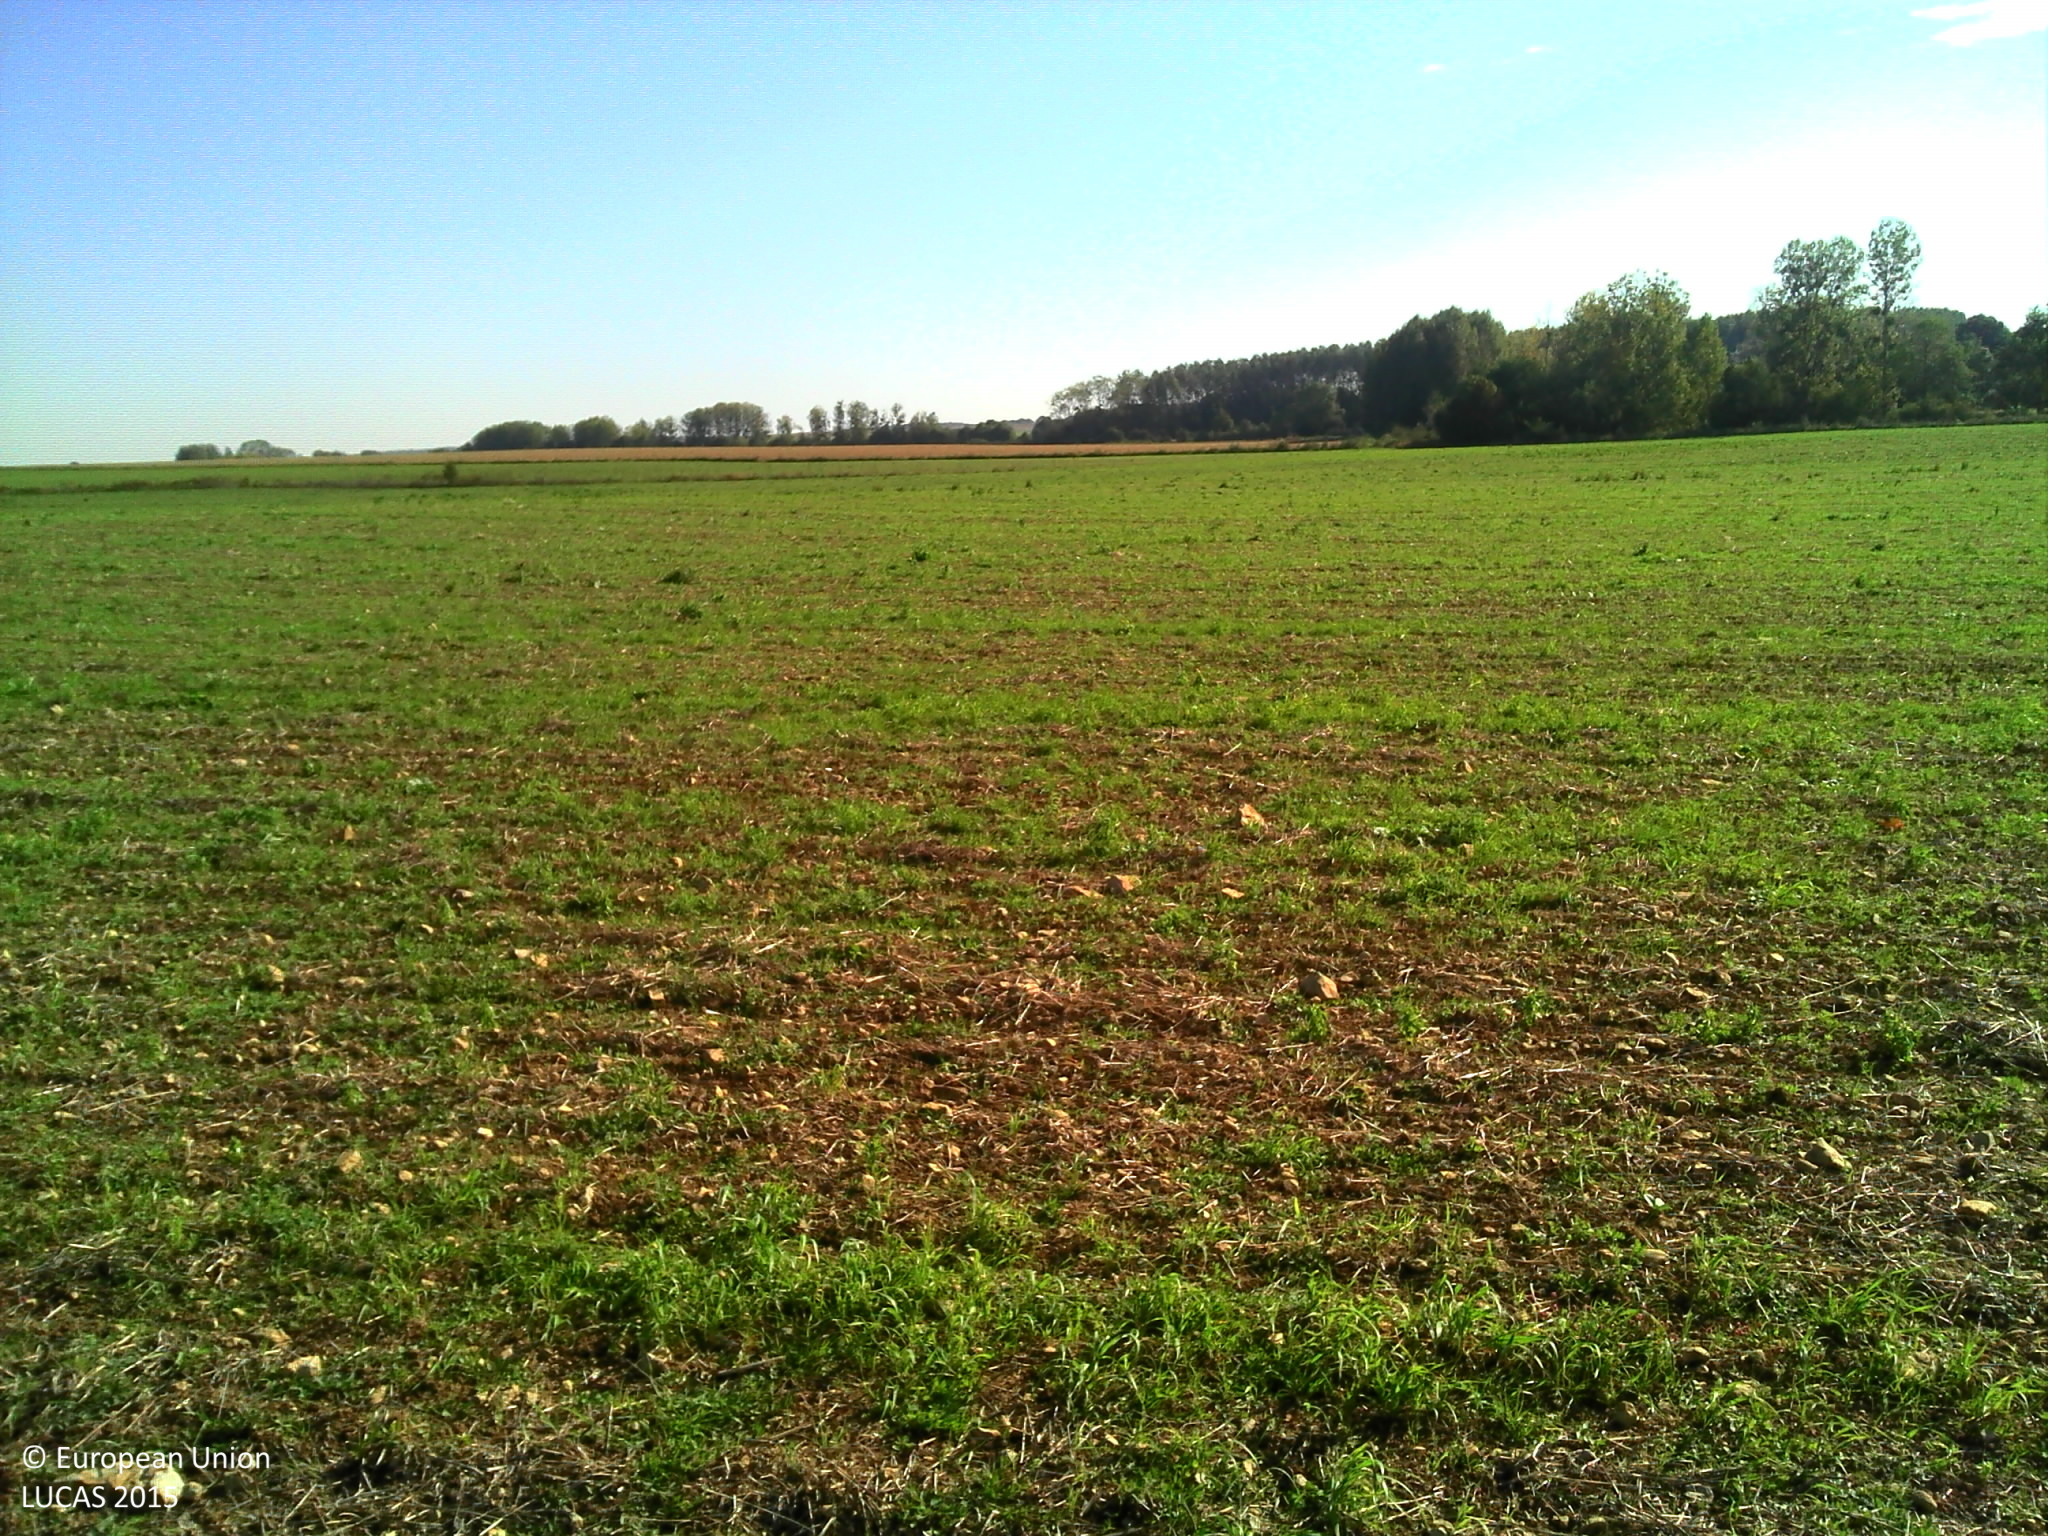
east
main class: Cropland
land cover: Other leguminous and mixtures for fodder
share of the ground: 10 - 25 %
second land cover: Other root crops
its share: 10 - 25 %
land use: Agriculture (excluding fallow land and kitchen gardens)
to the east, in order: Other leguminous and mixtures for fodder; Other root crops
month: September
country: FR
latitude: 46.5603
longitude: -1.0292
